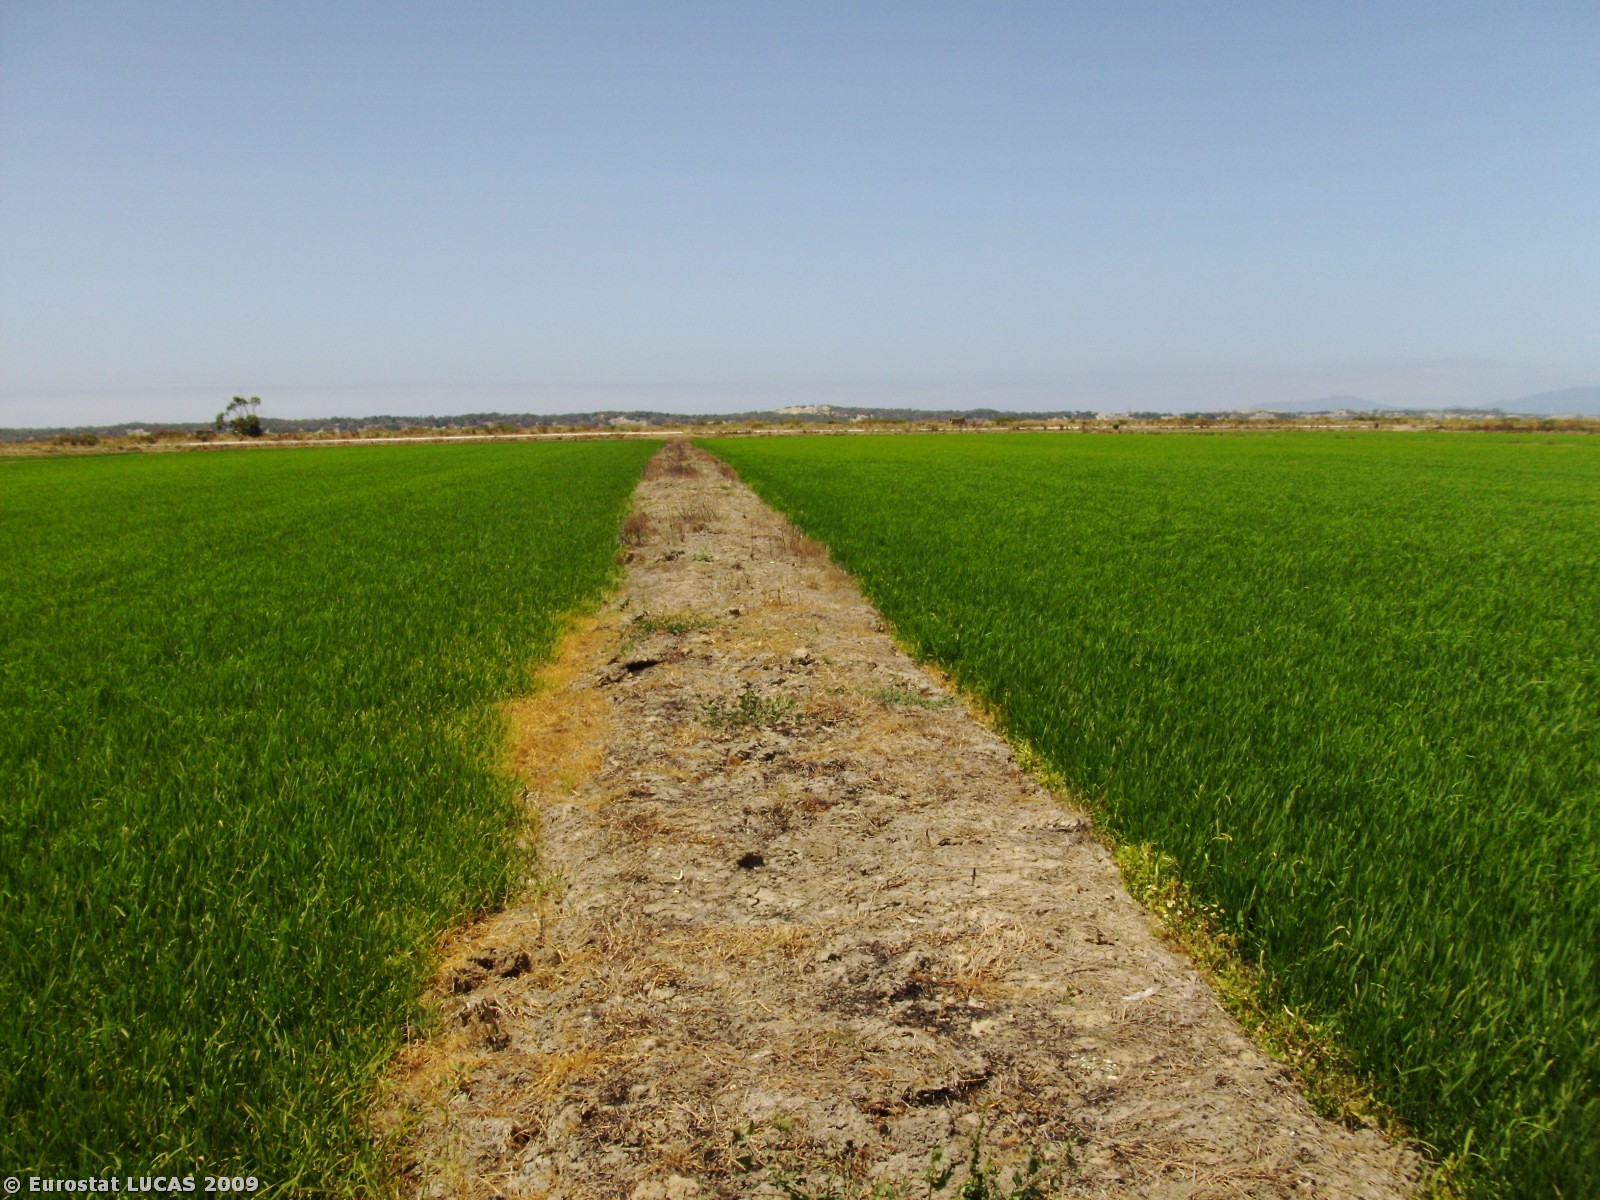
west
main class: Cropland
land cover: Rice
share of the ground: > 75 %
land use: Agriculture (excluding fallow land and kitchen gardens)
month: June
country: PT
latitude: 38.4158
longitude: -8.7847
